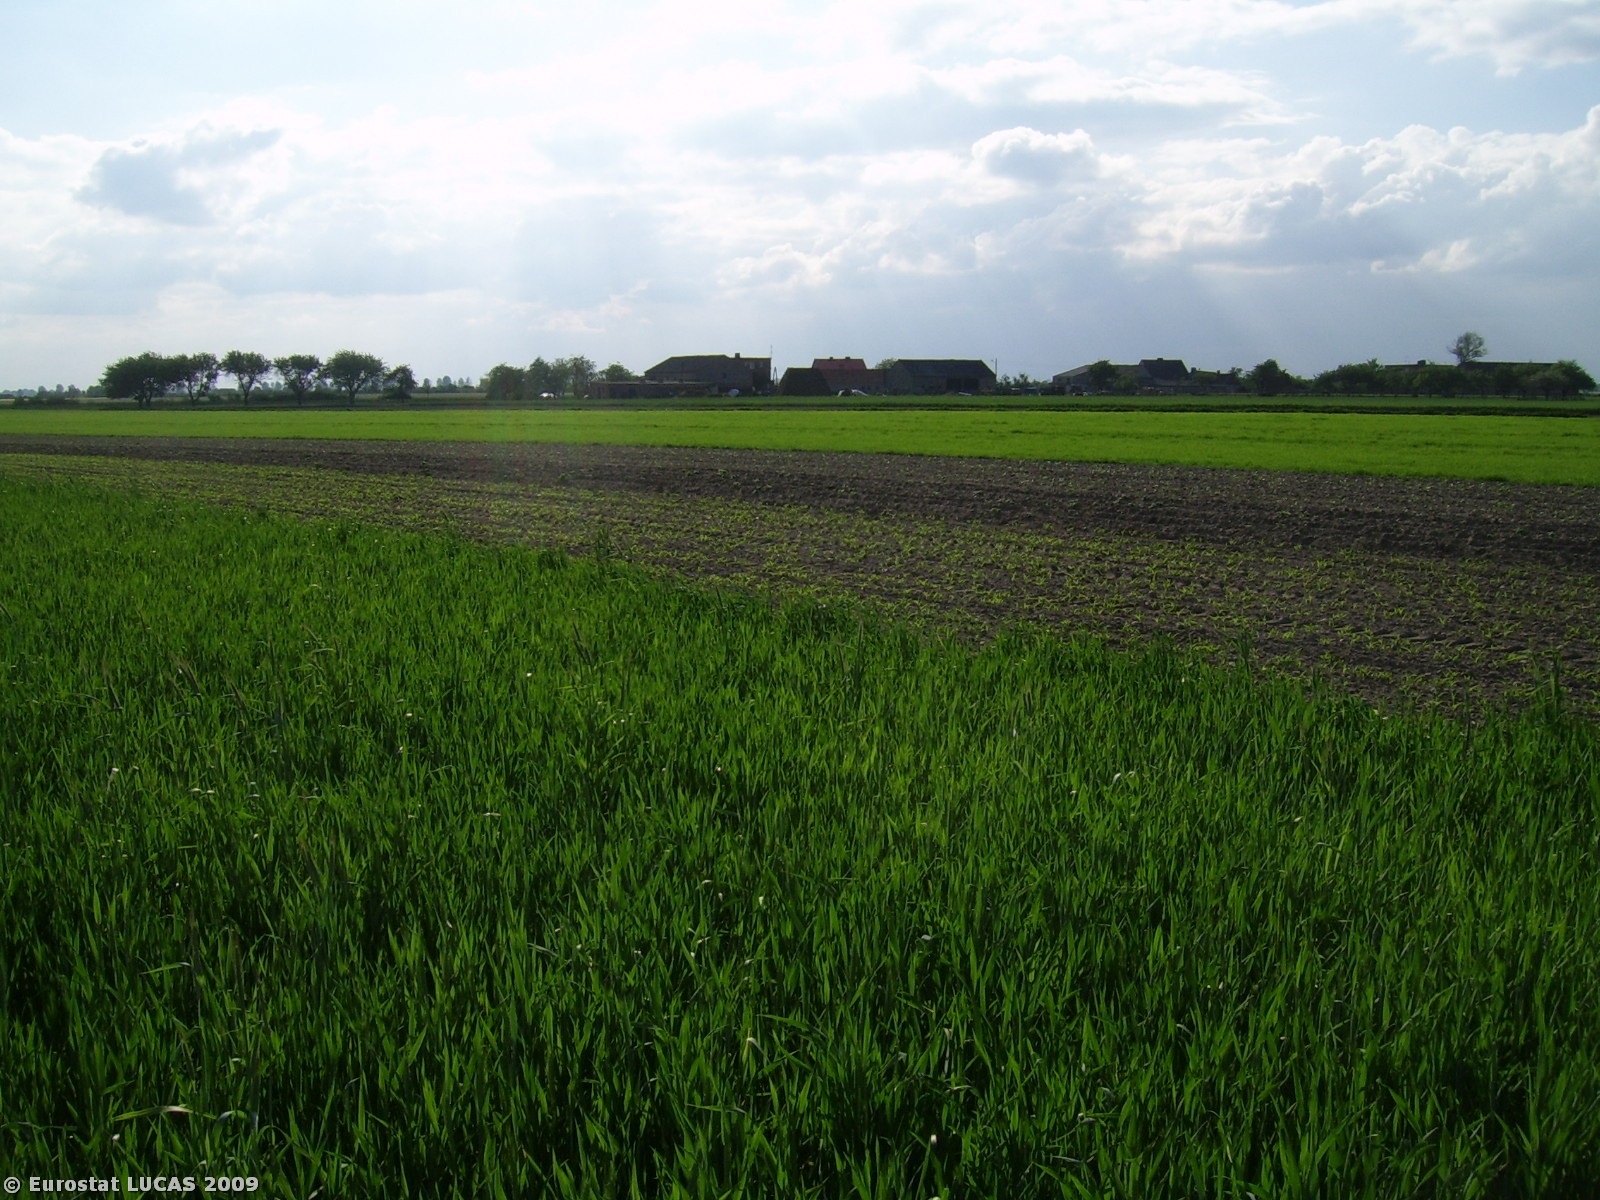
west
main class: Cropland
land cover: Triticale
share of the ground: > 75 %
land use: Agriculture (excluding fallow land and kitchen gardens)
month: May
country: PL
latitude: 51.8533
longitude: 16.8766
